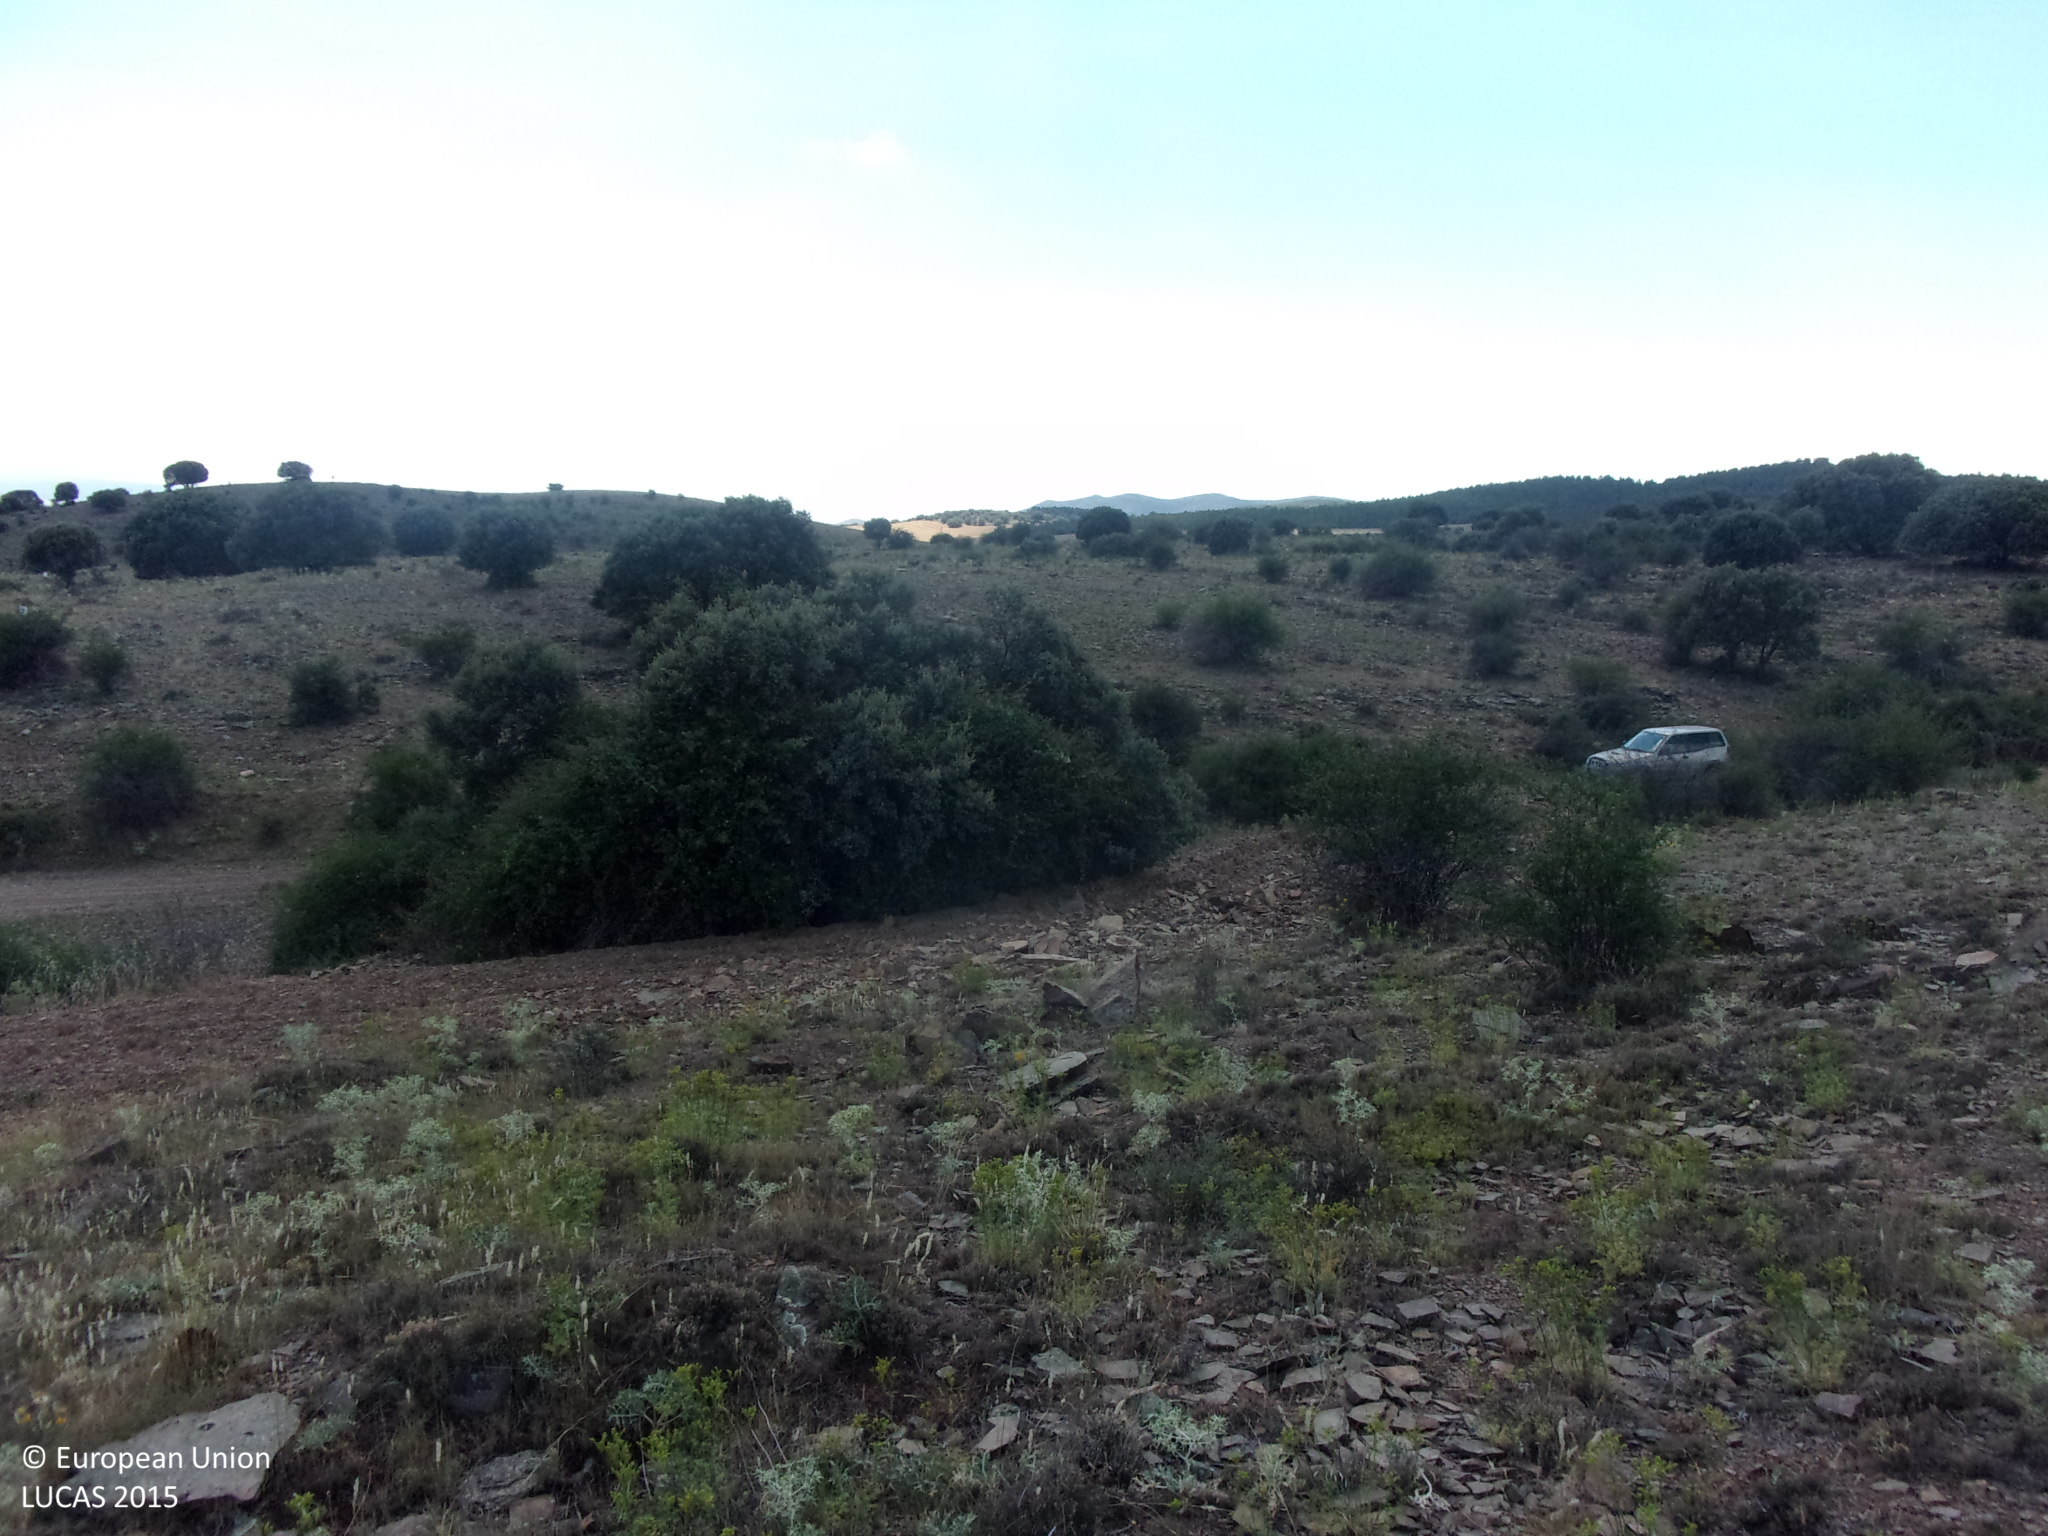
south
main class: Shrubland
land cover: Shrubland with sparse tree cover
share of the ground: > 75 %
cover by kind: shrubs 65 %, consolidated bare surface 20 %, herbaceous plants 10 %, broadleaved forest trees 5 %
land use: Semi-natural and natural areas not in use
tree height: < 5 m
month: July
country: ES
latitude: 40.9577
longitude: -1.3412
